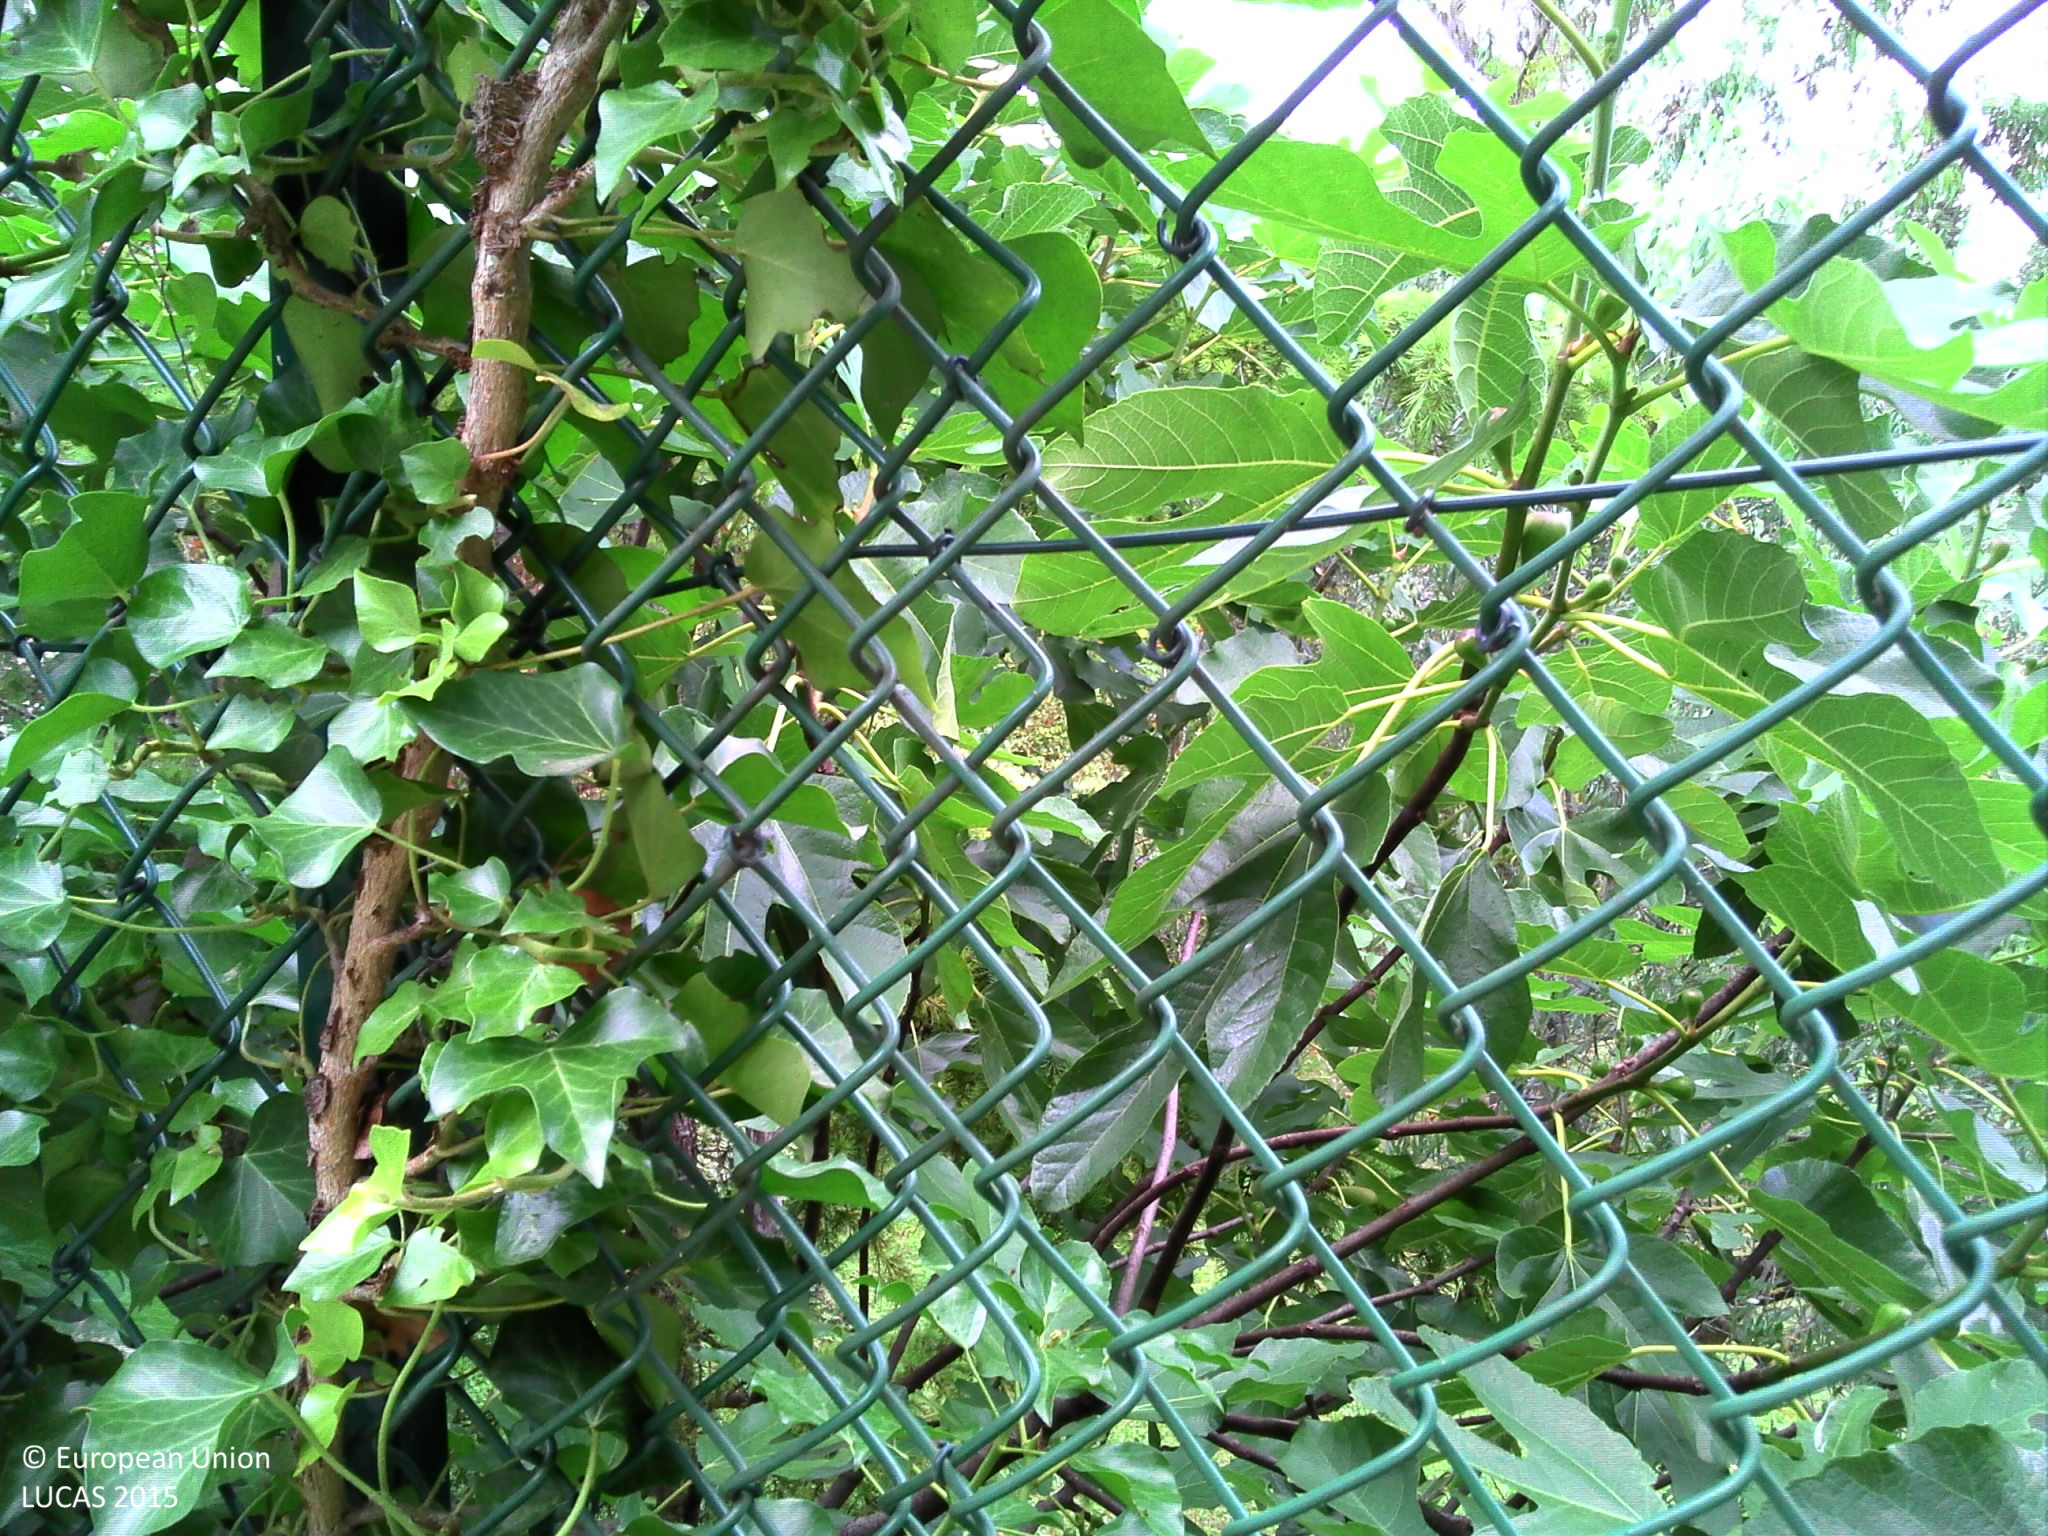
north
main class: Grassland
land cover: Grassland with sparse tree/shrub cover
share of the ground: > 75 %
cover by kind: herbaceous plants 95 %, broadleaved forest trees 5 %
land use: Residential
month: June
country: FR
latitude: 43.6759
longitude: 7.0180
